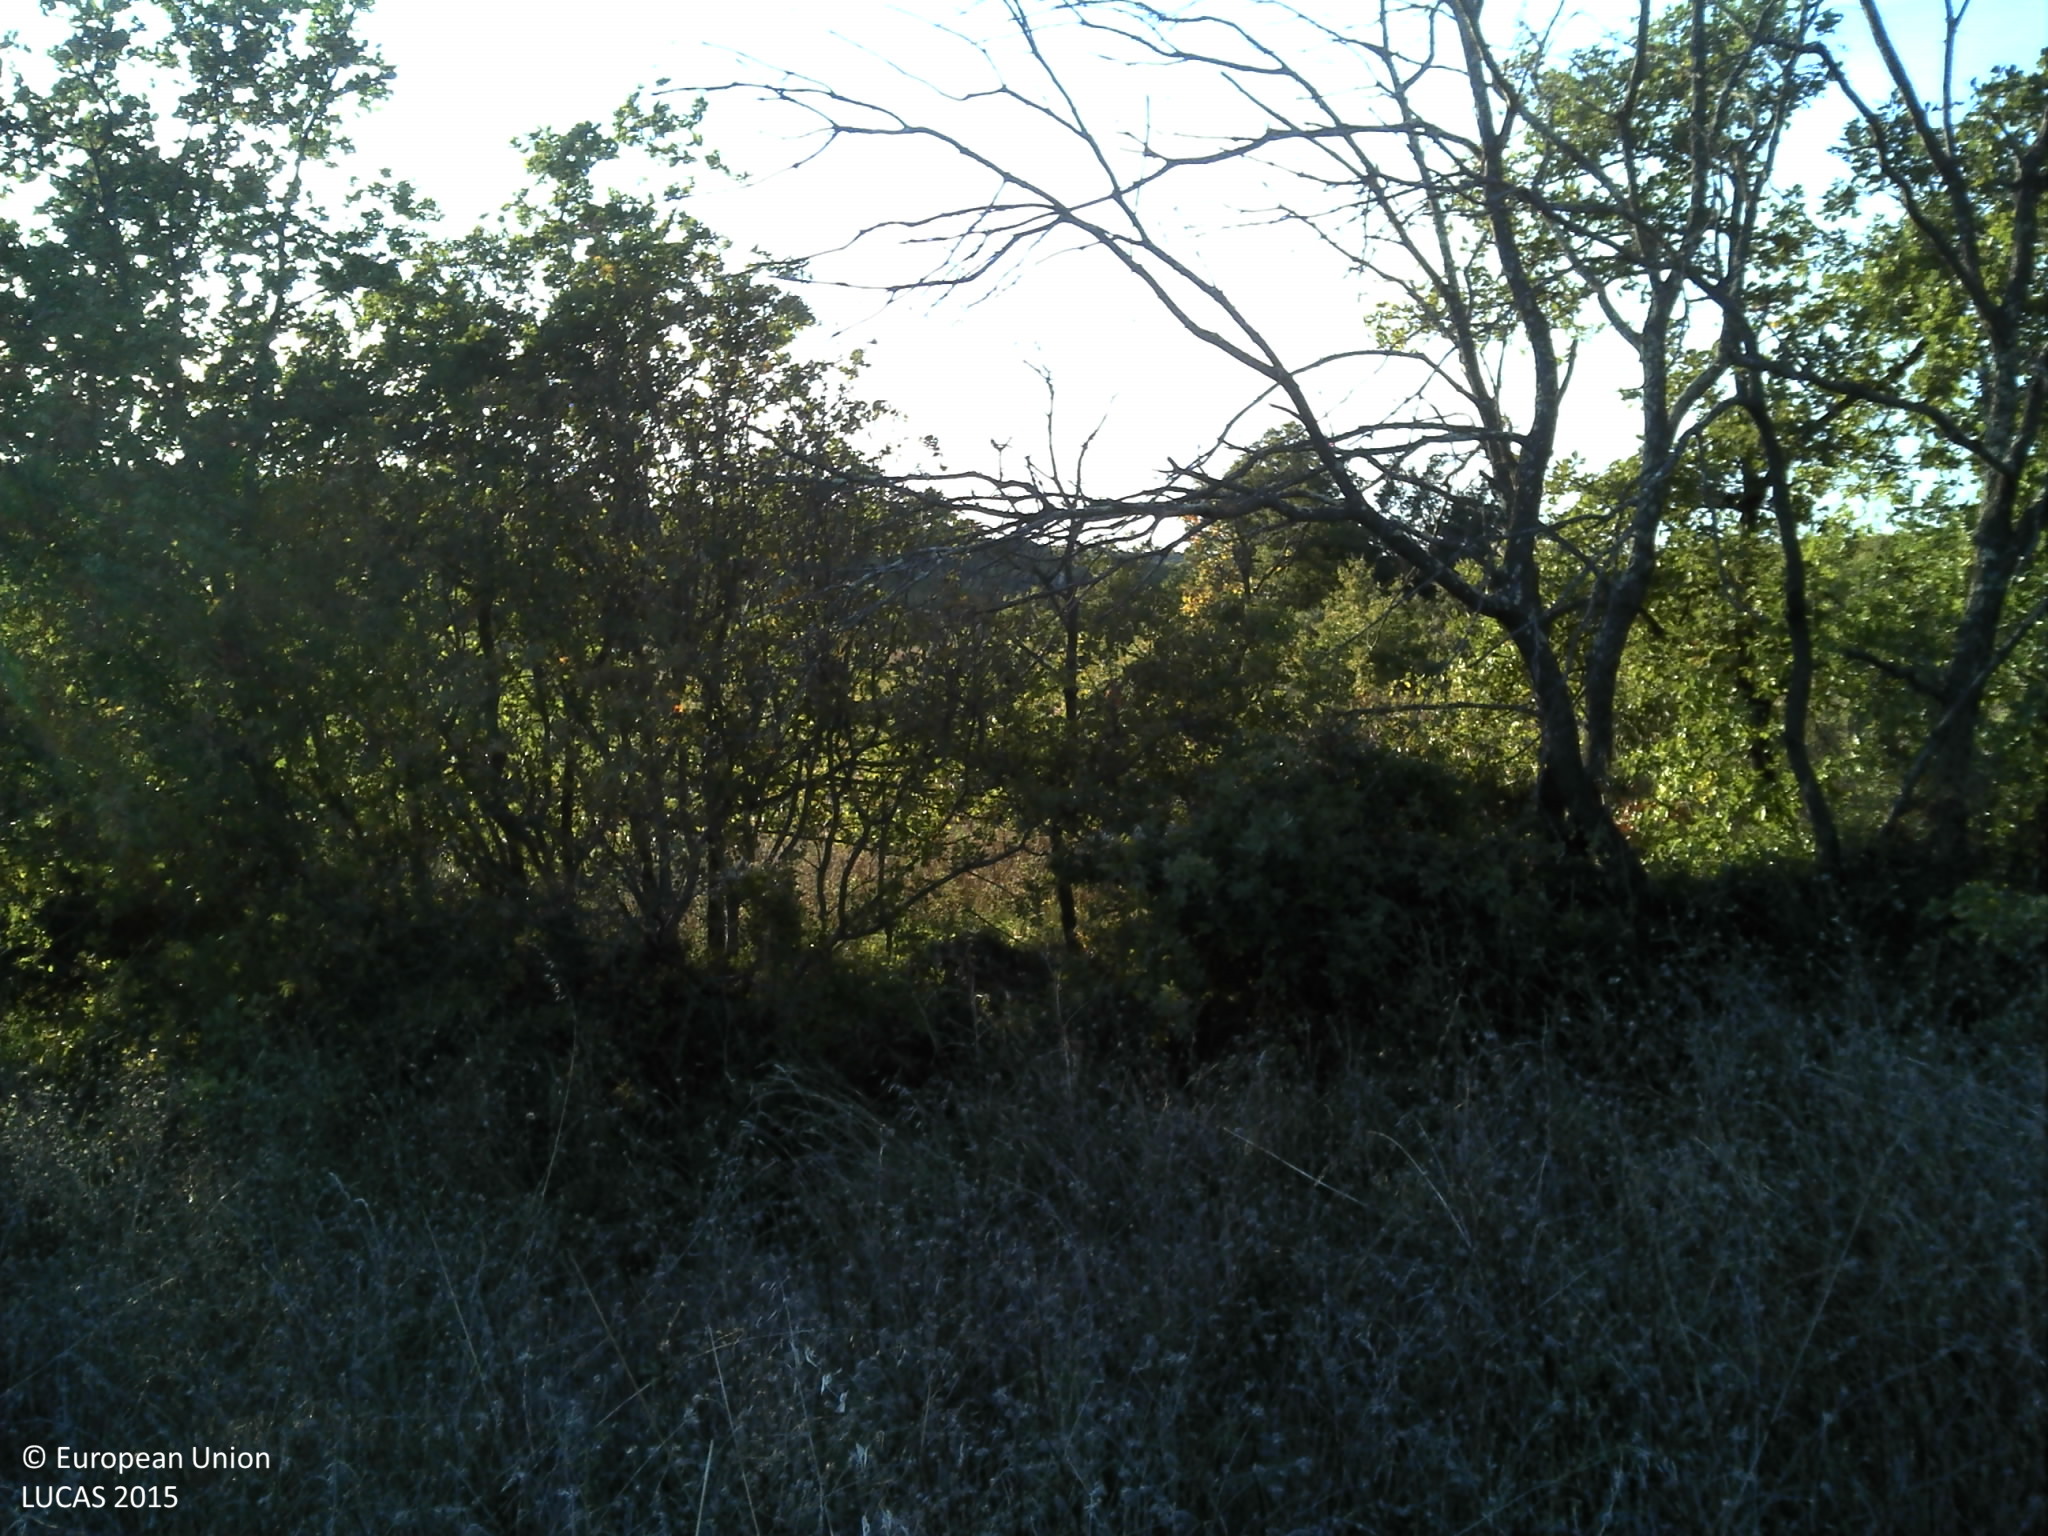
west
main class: Grassland
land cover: Spontaneously vegetated surfaces
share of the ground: > 75 %
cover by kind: herbaceous plants 95 %, shrubs 5 %
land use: Abandoned areas
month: October
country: FR
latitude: 43.5080
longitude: 3.4163
